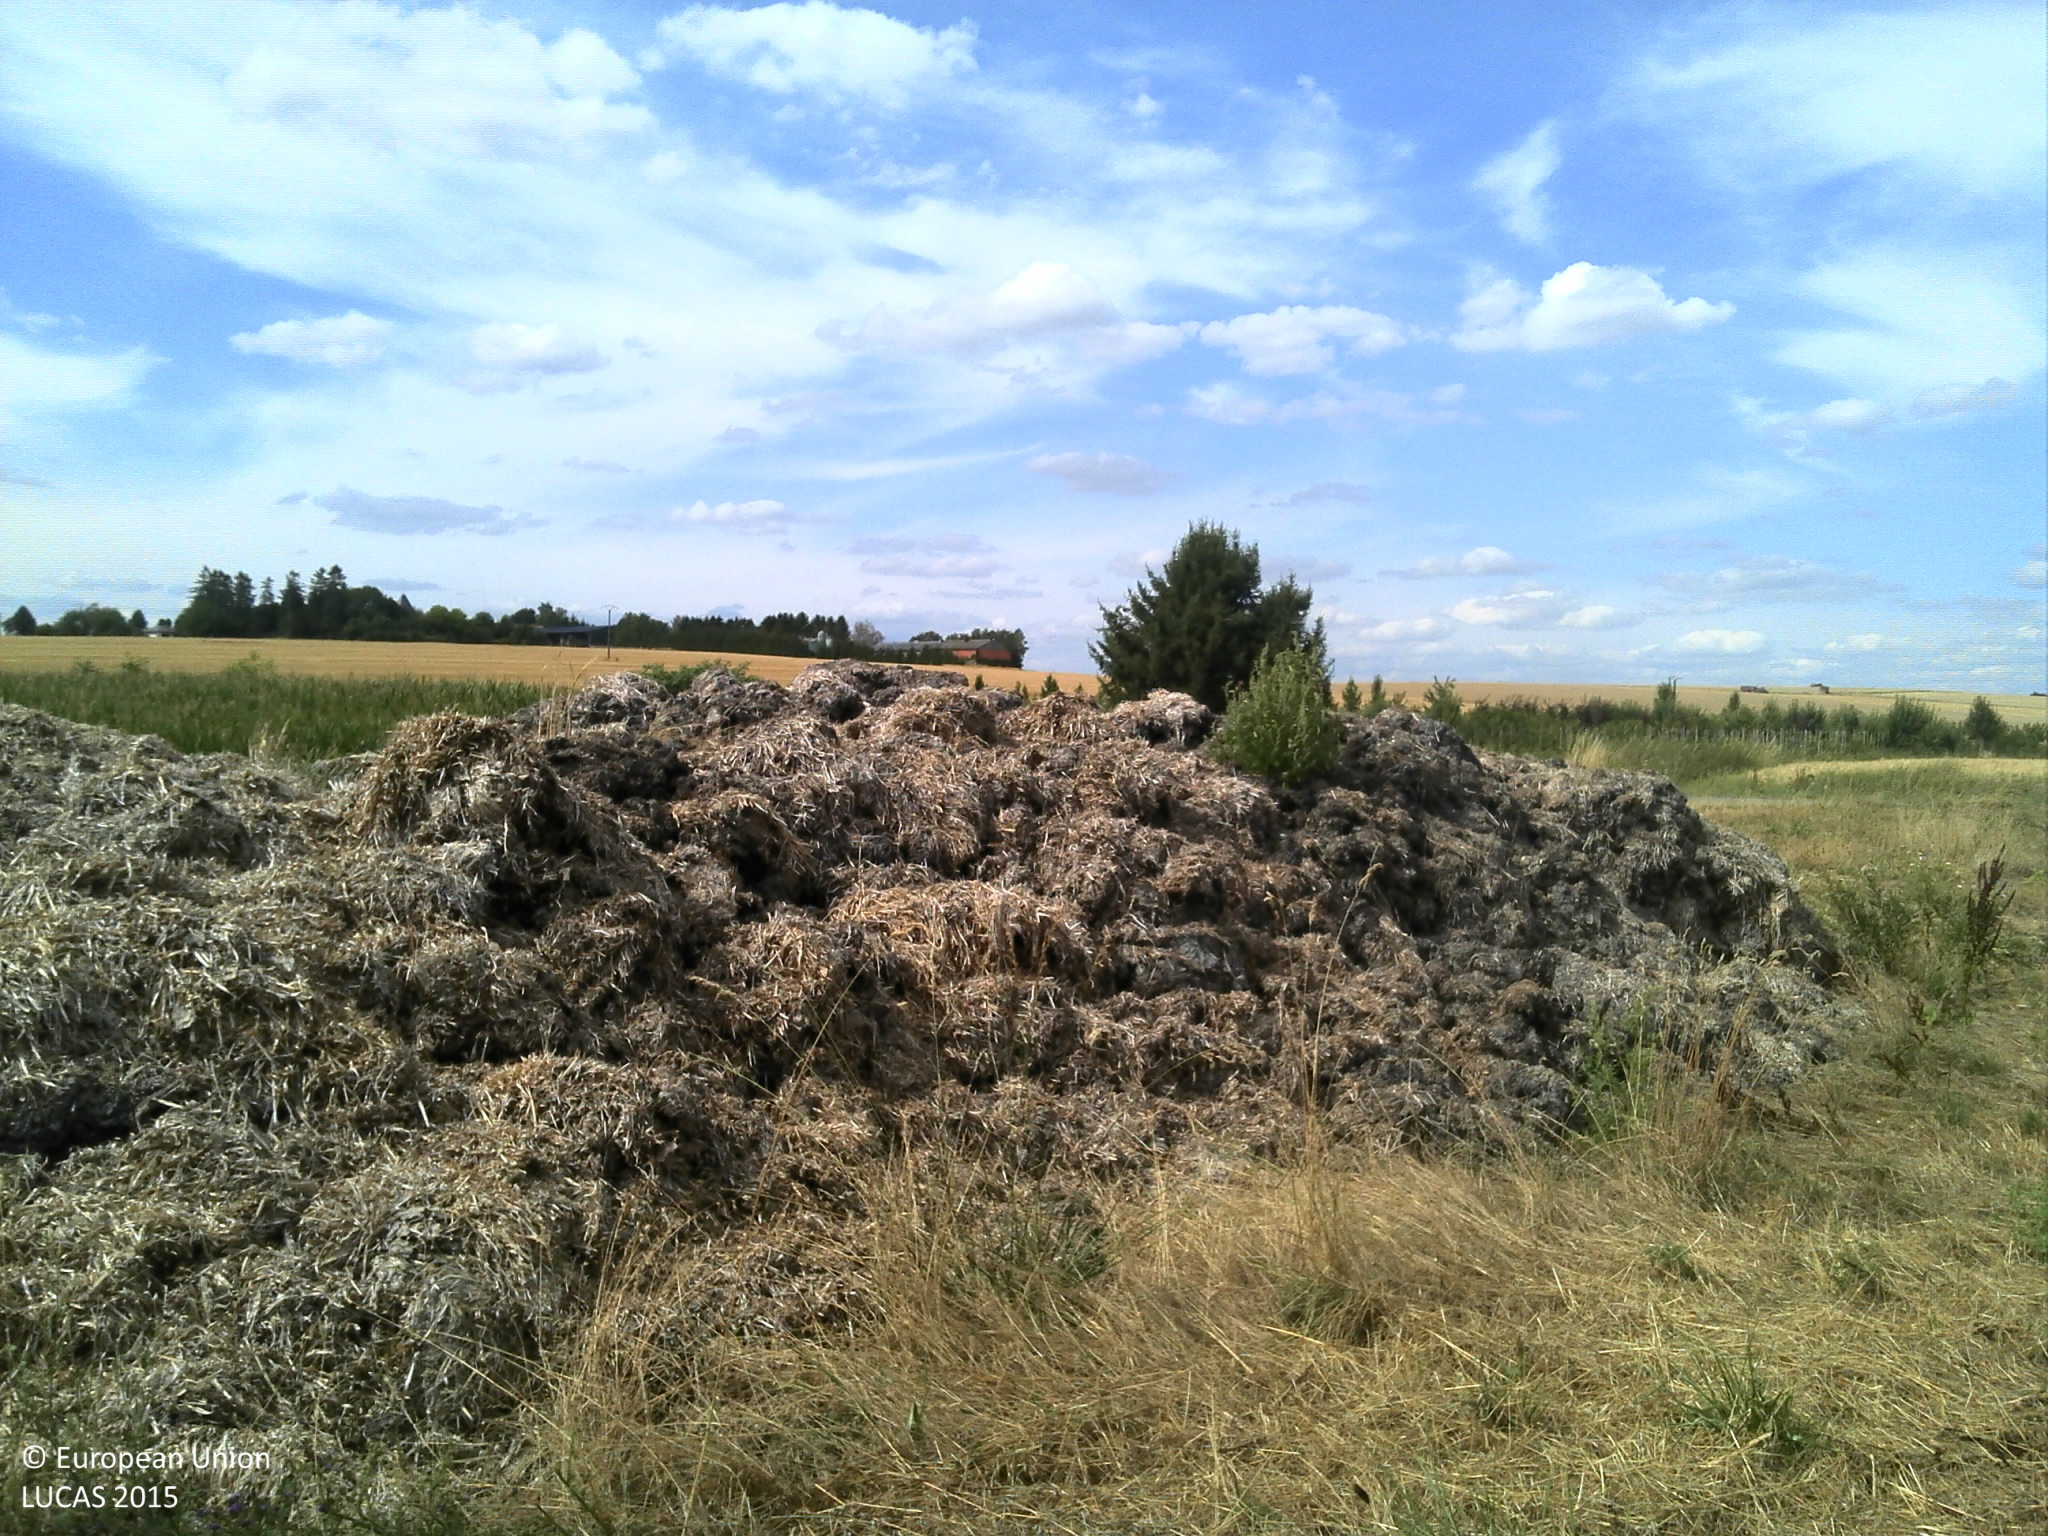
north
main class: Grassland
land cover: Grassland without tree/shrub cover
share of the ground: > 75 %
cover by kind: herbaceous plants 100 %
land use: Agriculture (excluding fallow land and kitchen gardens)
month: July
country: FR
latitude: 49.4975
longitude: 4.5979
